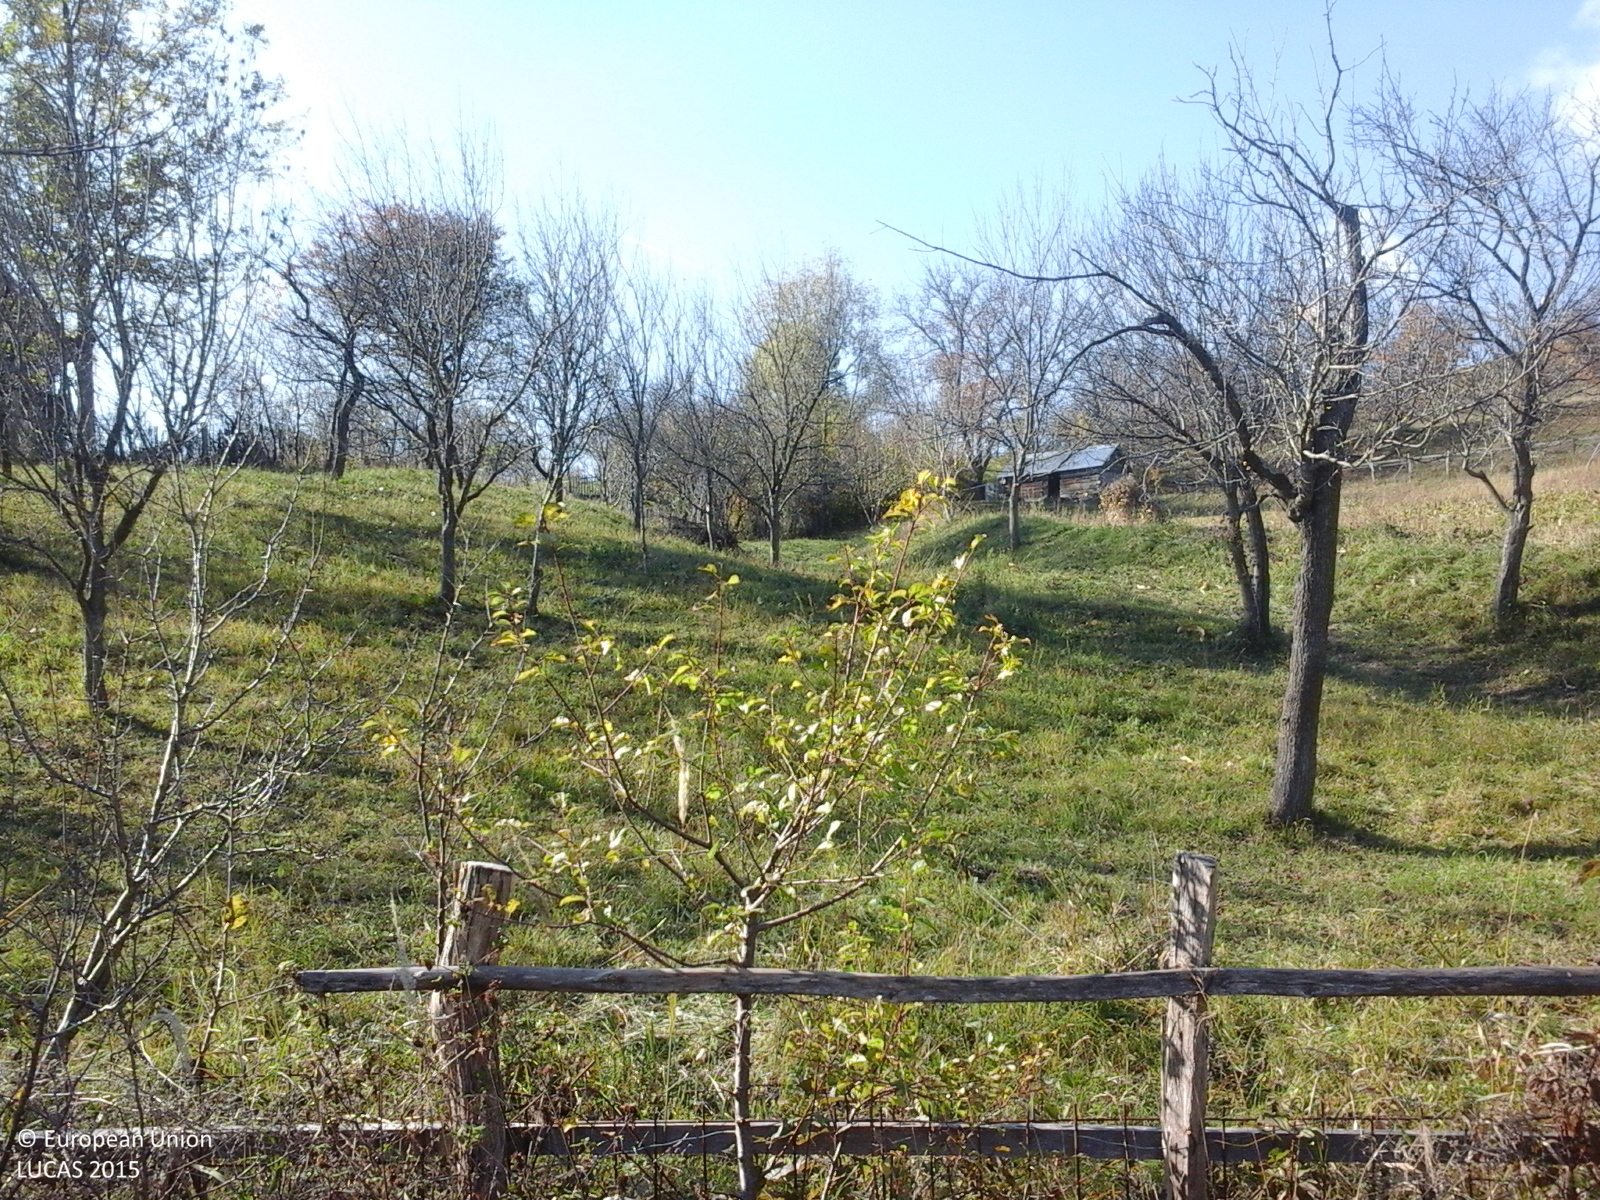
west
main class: Cropland
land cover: Other fruit trees and berries
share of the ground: 50 - 75 %
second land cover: Grassland without tree/shrub cover
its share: > 75 %
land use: Agriculture (excluding fallow land and kitchen gardens)
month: October
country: RO
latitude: 45.4088
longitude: 26.4918
